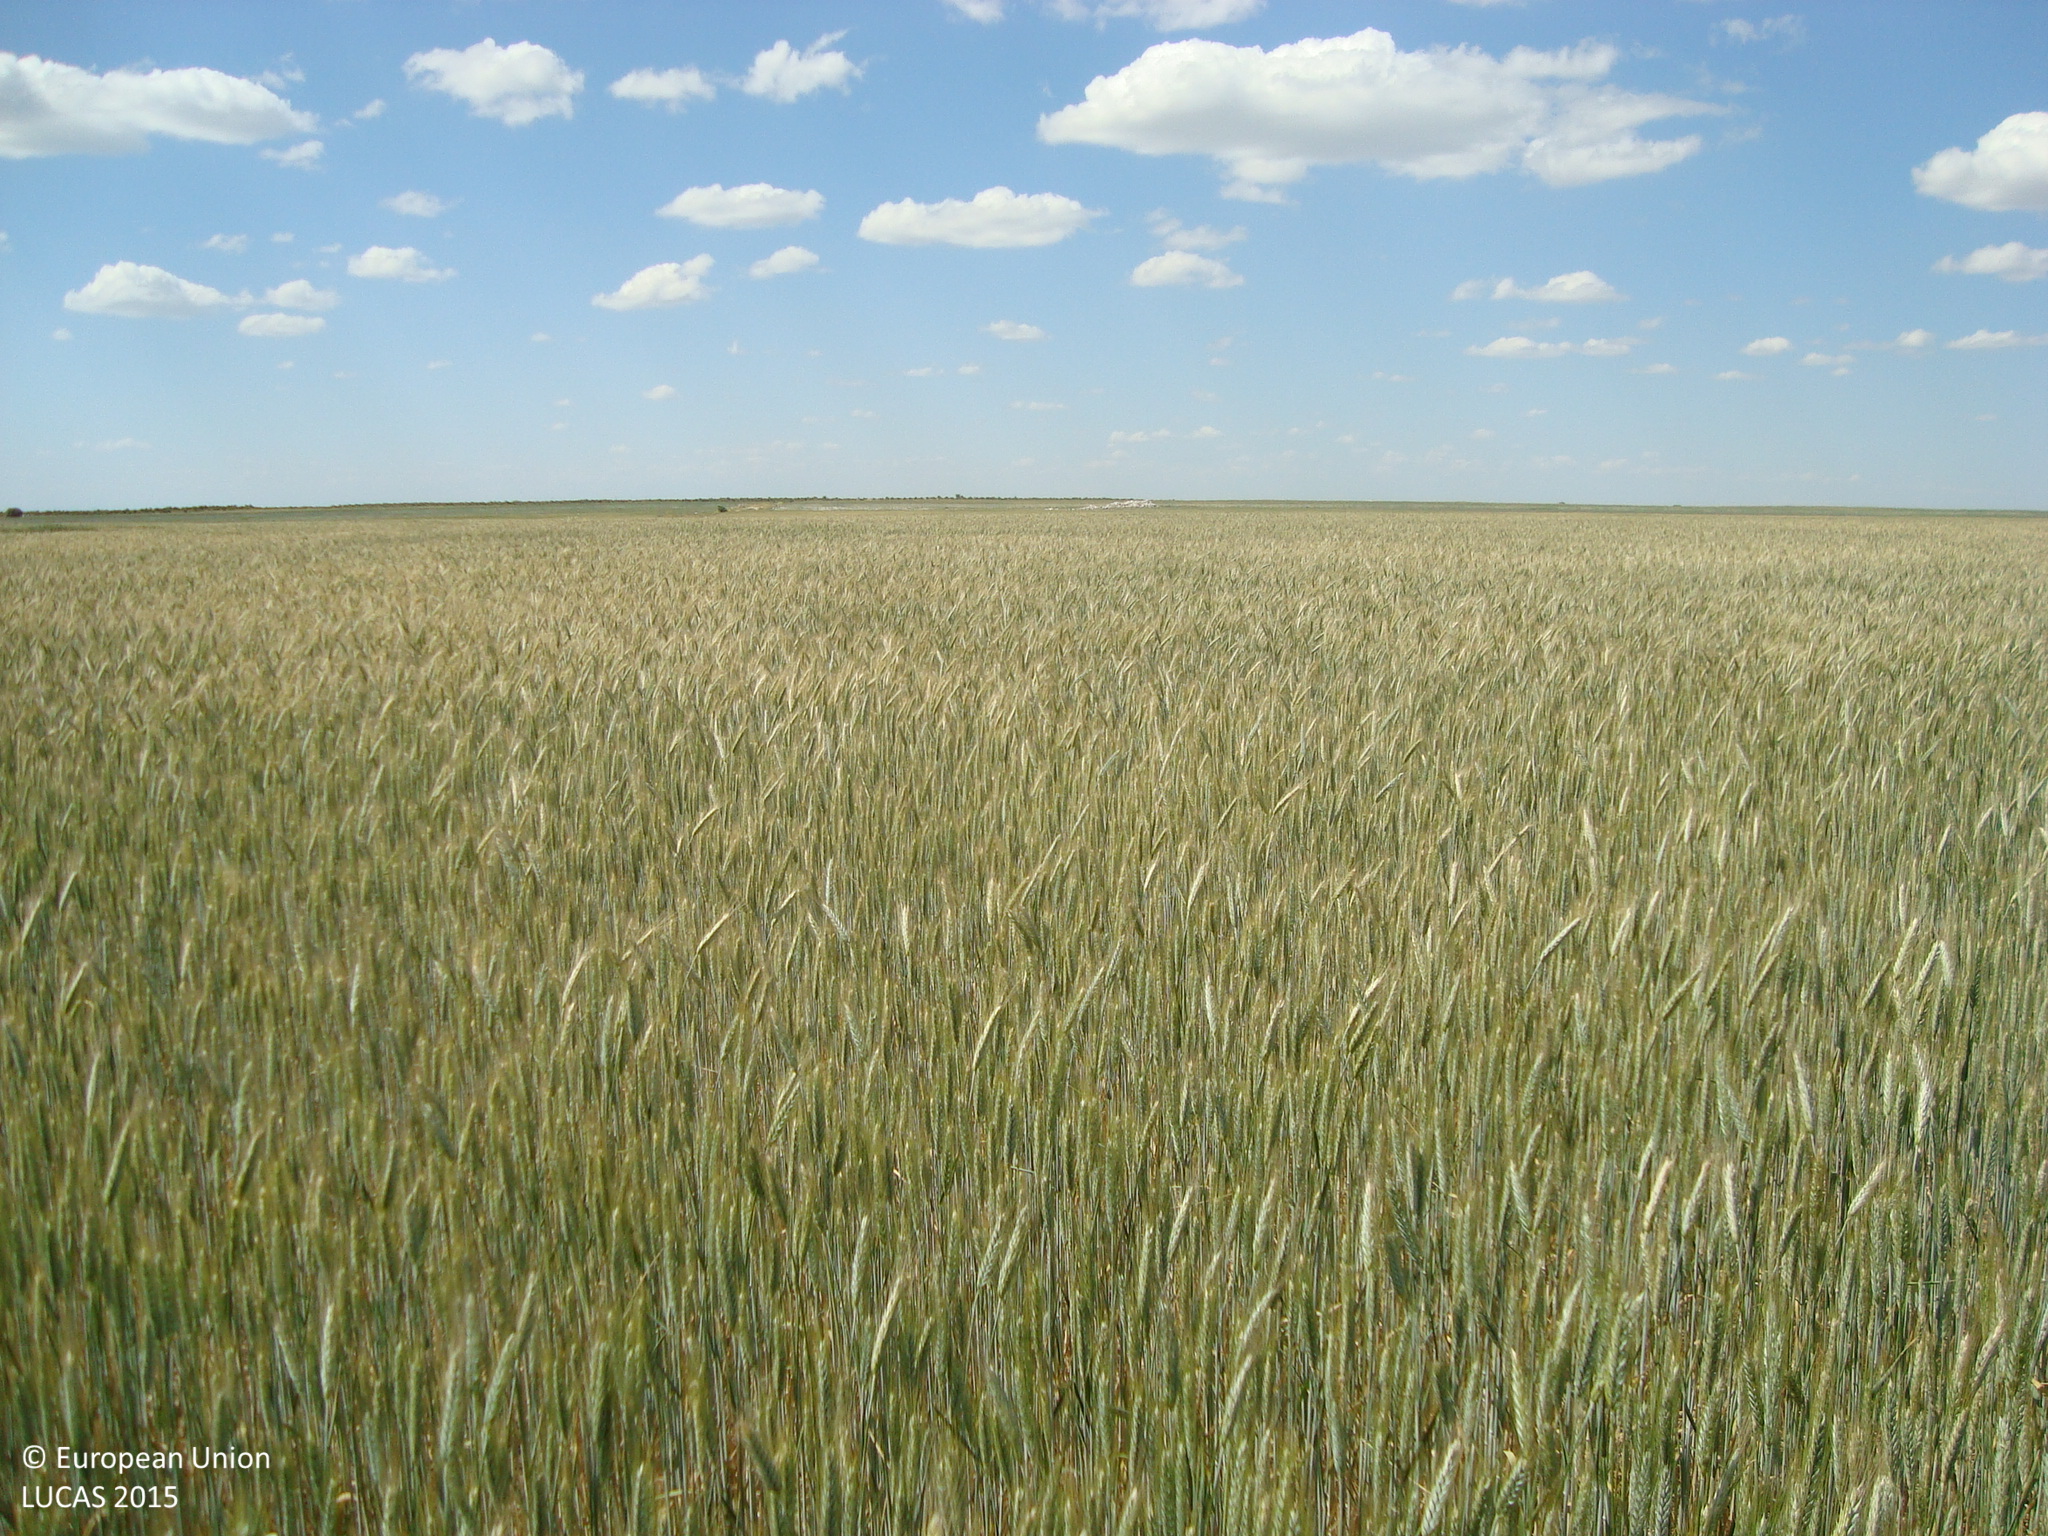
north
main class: Cropland
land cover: Rye
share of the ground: > 75 %
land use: Agriculture (excluding fallow land and kitchen gardens)
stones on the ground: < 10 %
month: May
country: ES
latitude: 41.5483
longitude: -3.9984
